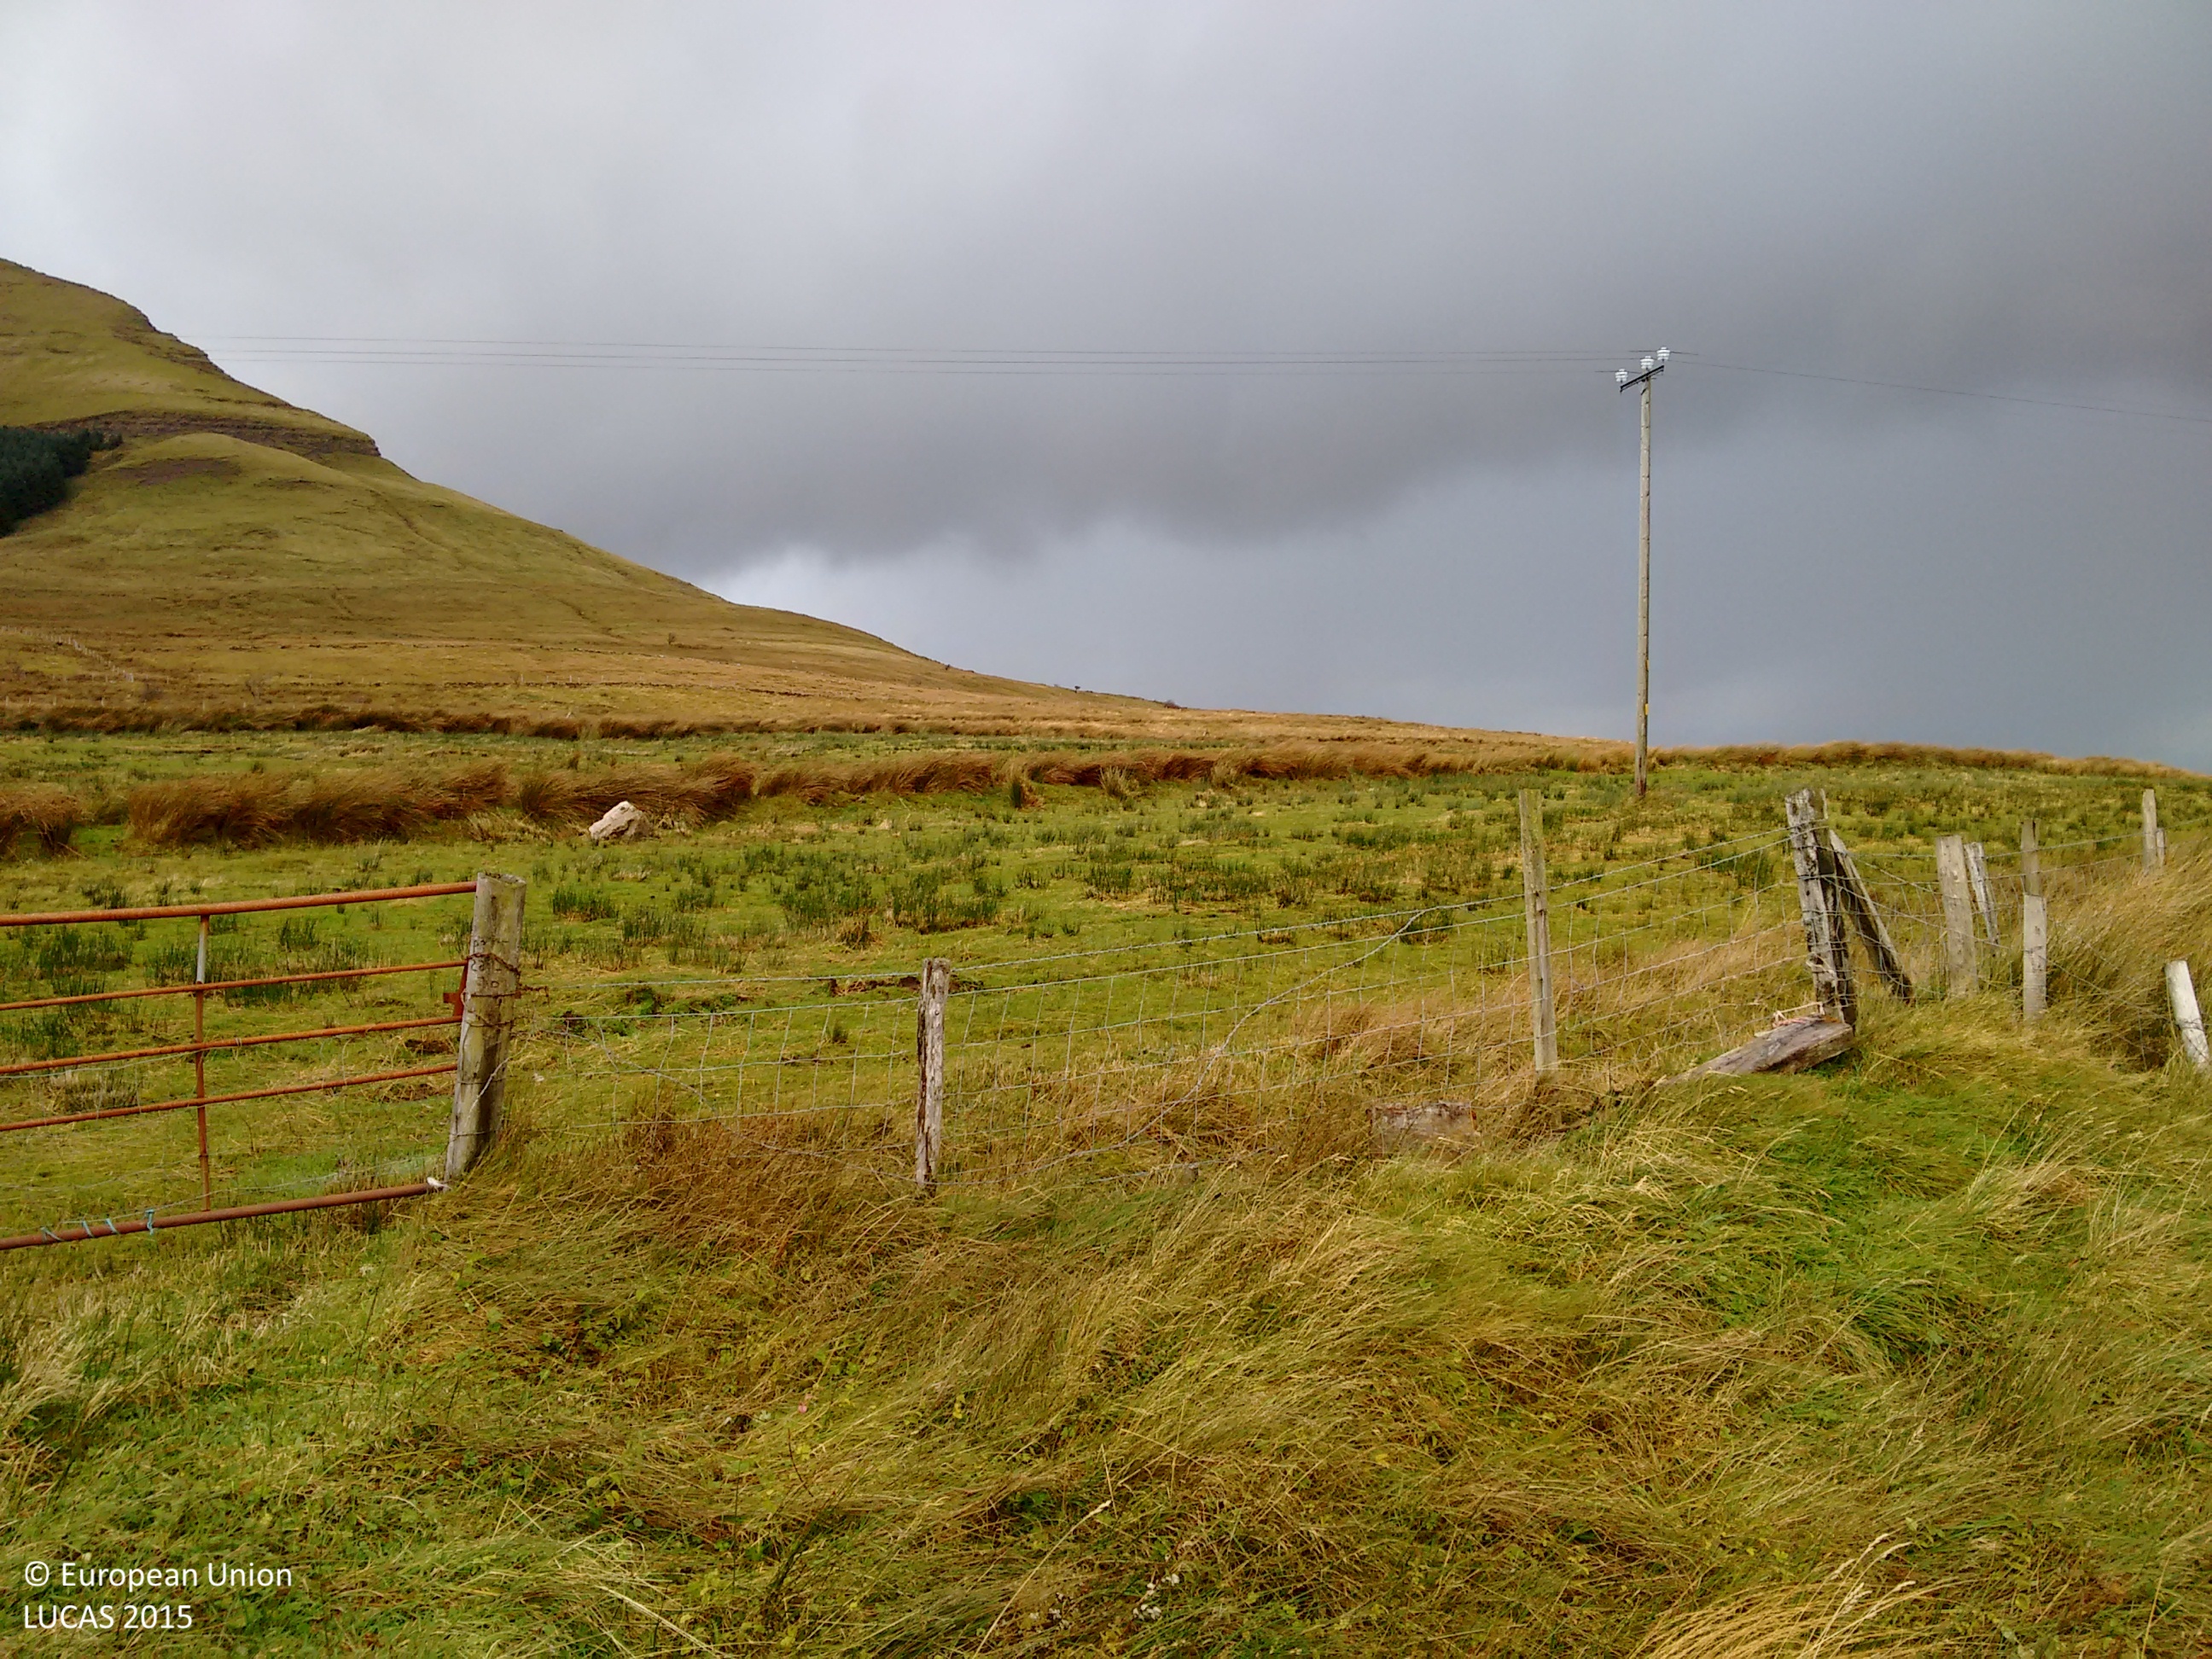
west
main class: Grassland
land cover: Grassland without tree/shrub cover
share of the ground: > 75 %
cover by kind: herbaceous plants 100 %
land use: Agriculture (excluding fallow land and kitchen gardens)
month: November
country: IE
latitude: 54.3935
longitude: -8.4078
